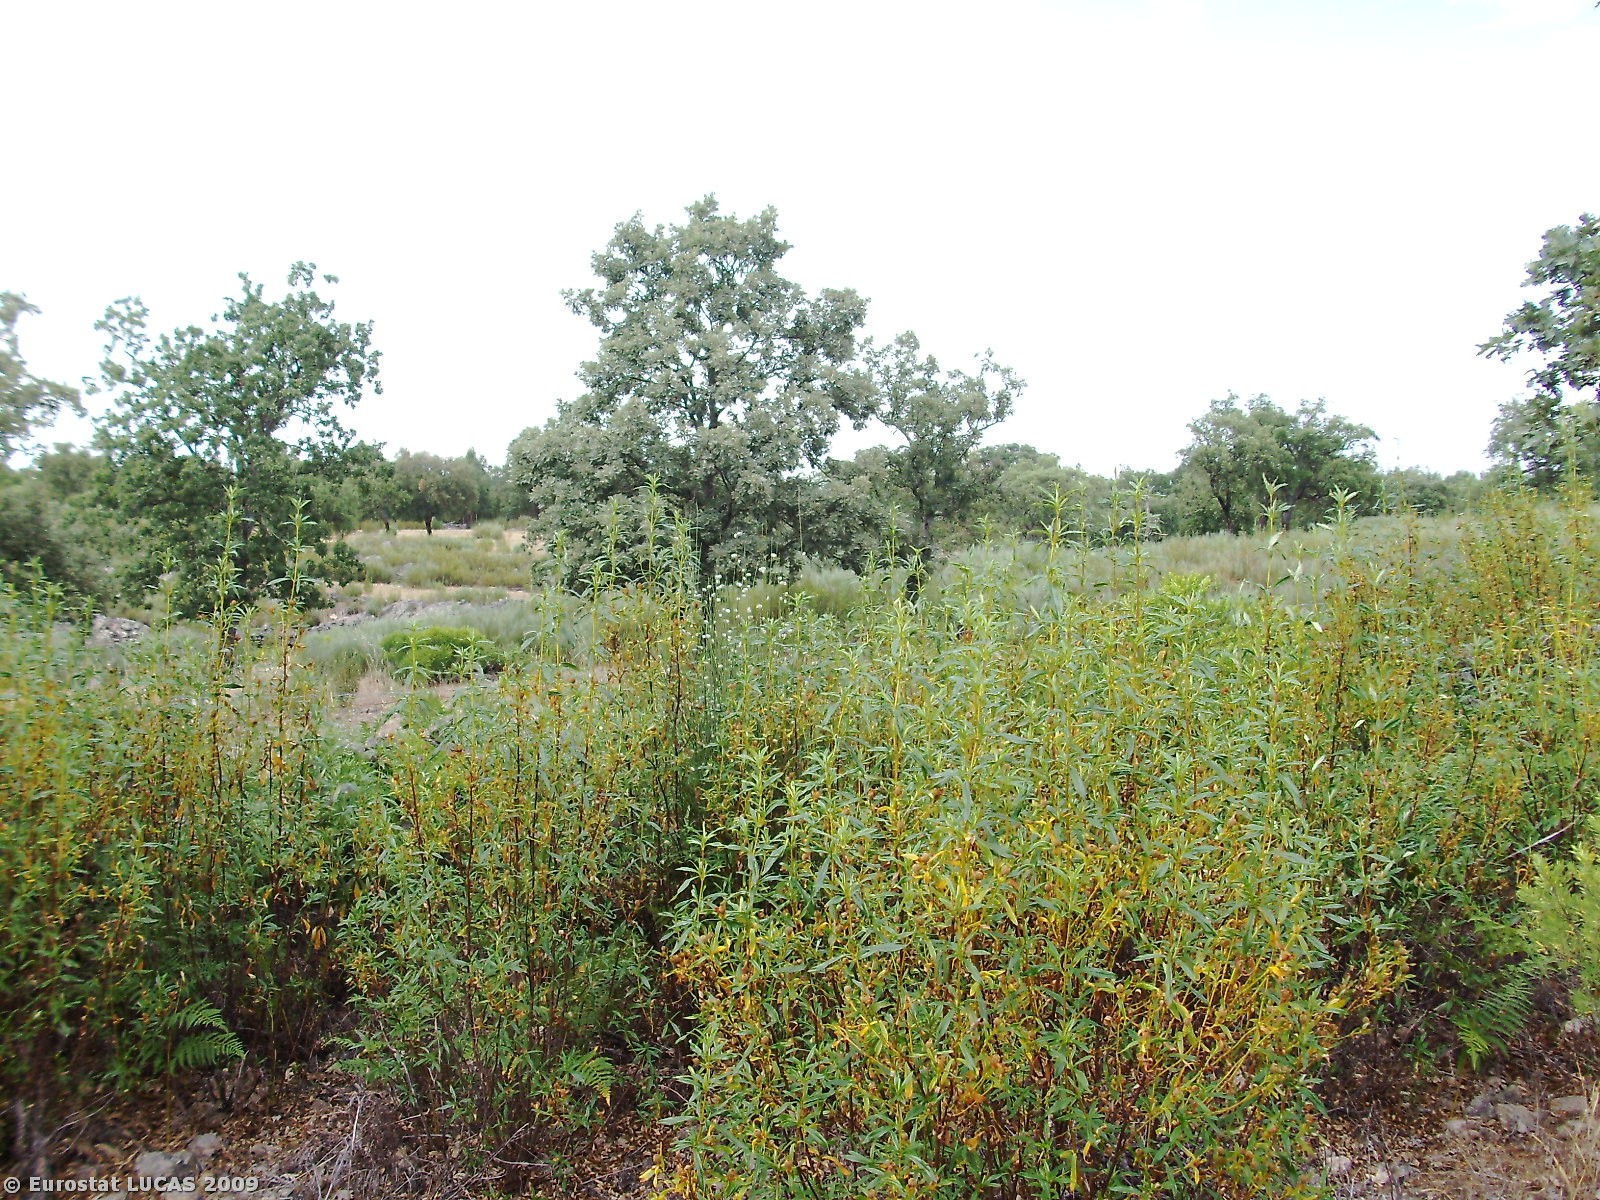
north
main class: Woodland
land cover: Broadleaved woodland
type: broadleaved evergreen forest
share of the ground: 25 - 50 %
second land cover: Spontaneously vegetated surfaces
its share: 50 - 75 %
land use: Forestry
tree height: > 5 m
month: June
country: PT
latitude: 39.3833
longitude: -7.4937
